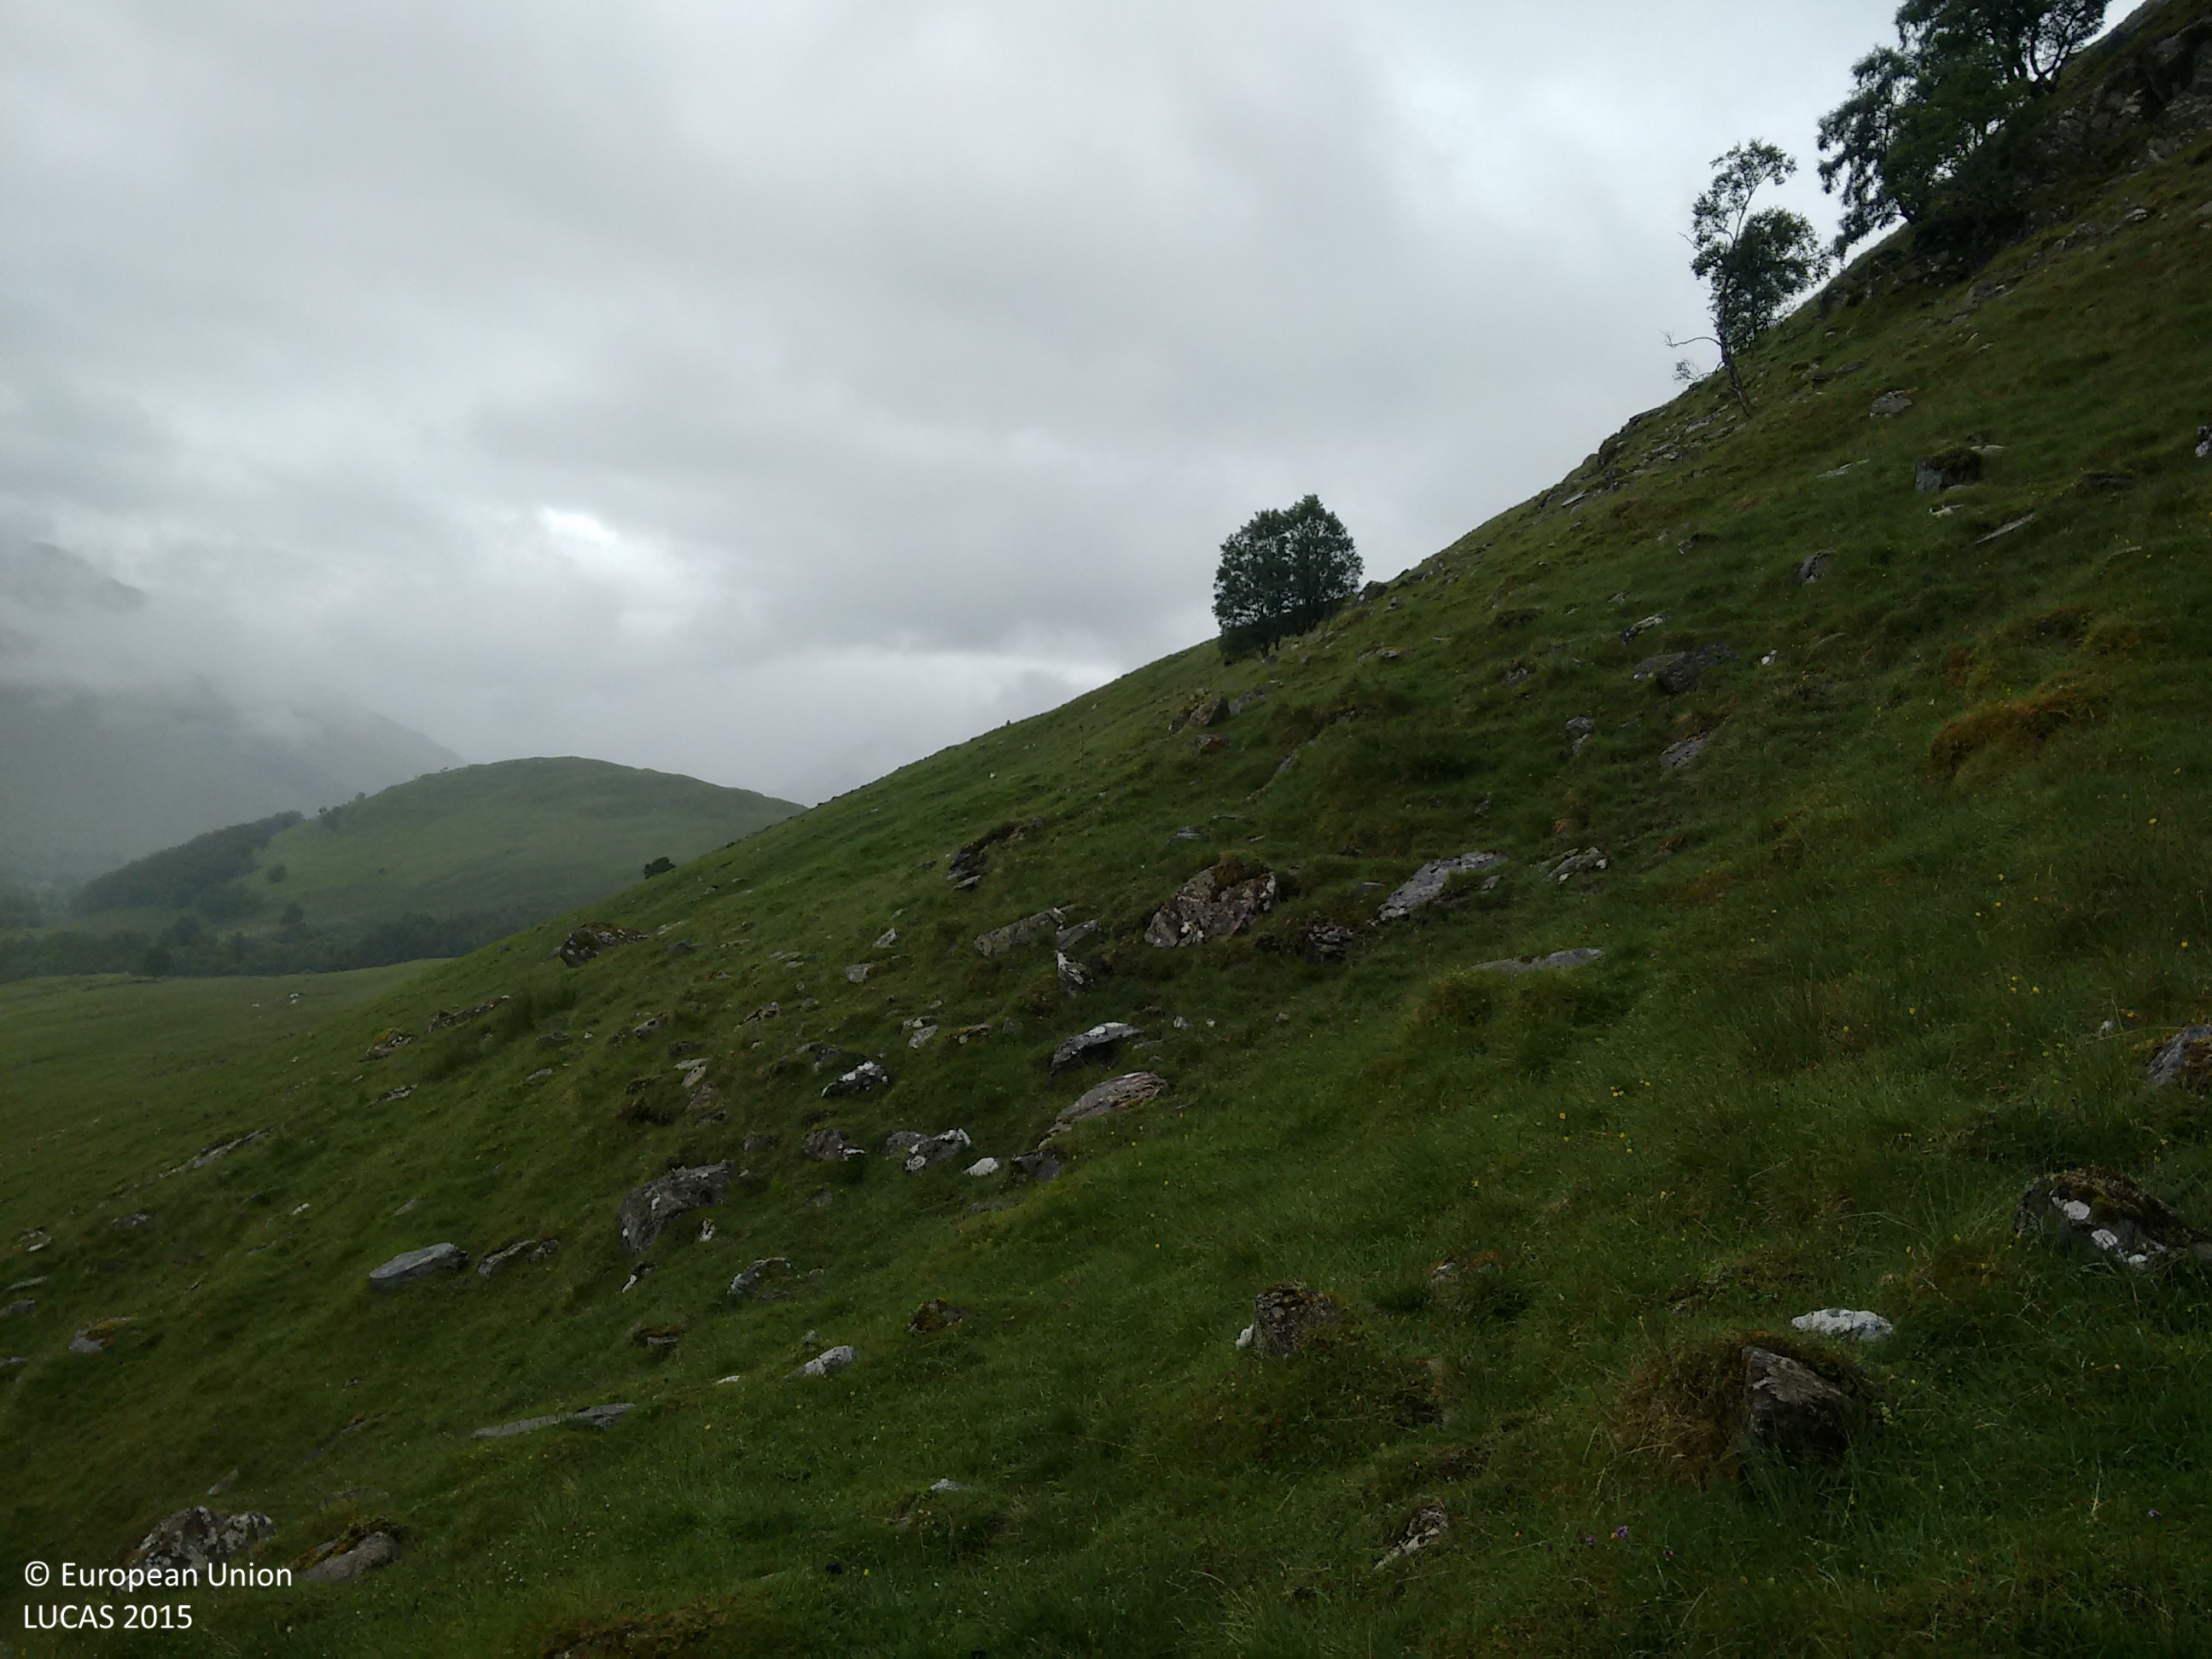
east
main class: Grassland
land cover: Grassland without tree/shrub cover
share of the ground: > 75 %
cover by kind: herbaceous plants 90 %, lichens and mosses 10 %
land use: Agriculture (excluding fallow land and kitchen gardens)
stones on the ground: < 10 %
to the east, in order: Grassland without tree/shrub cover; Rocks and stones; Grassland without tree/shrub cover
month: July
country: GB
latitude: 56.5915
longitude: -4.2745
